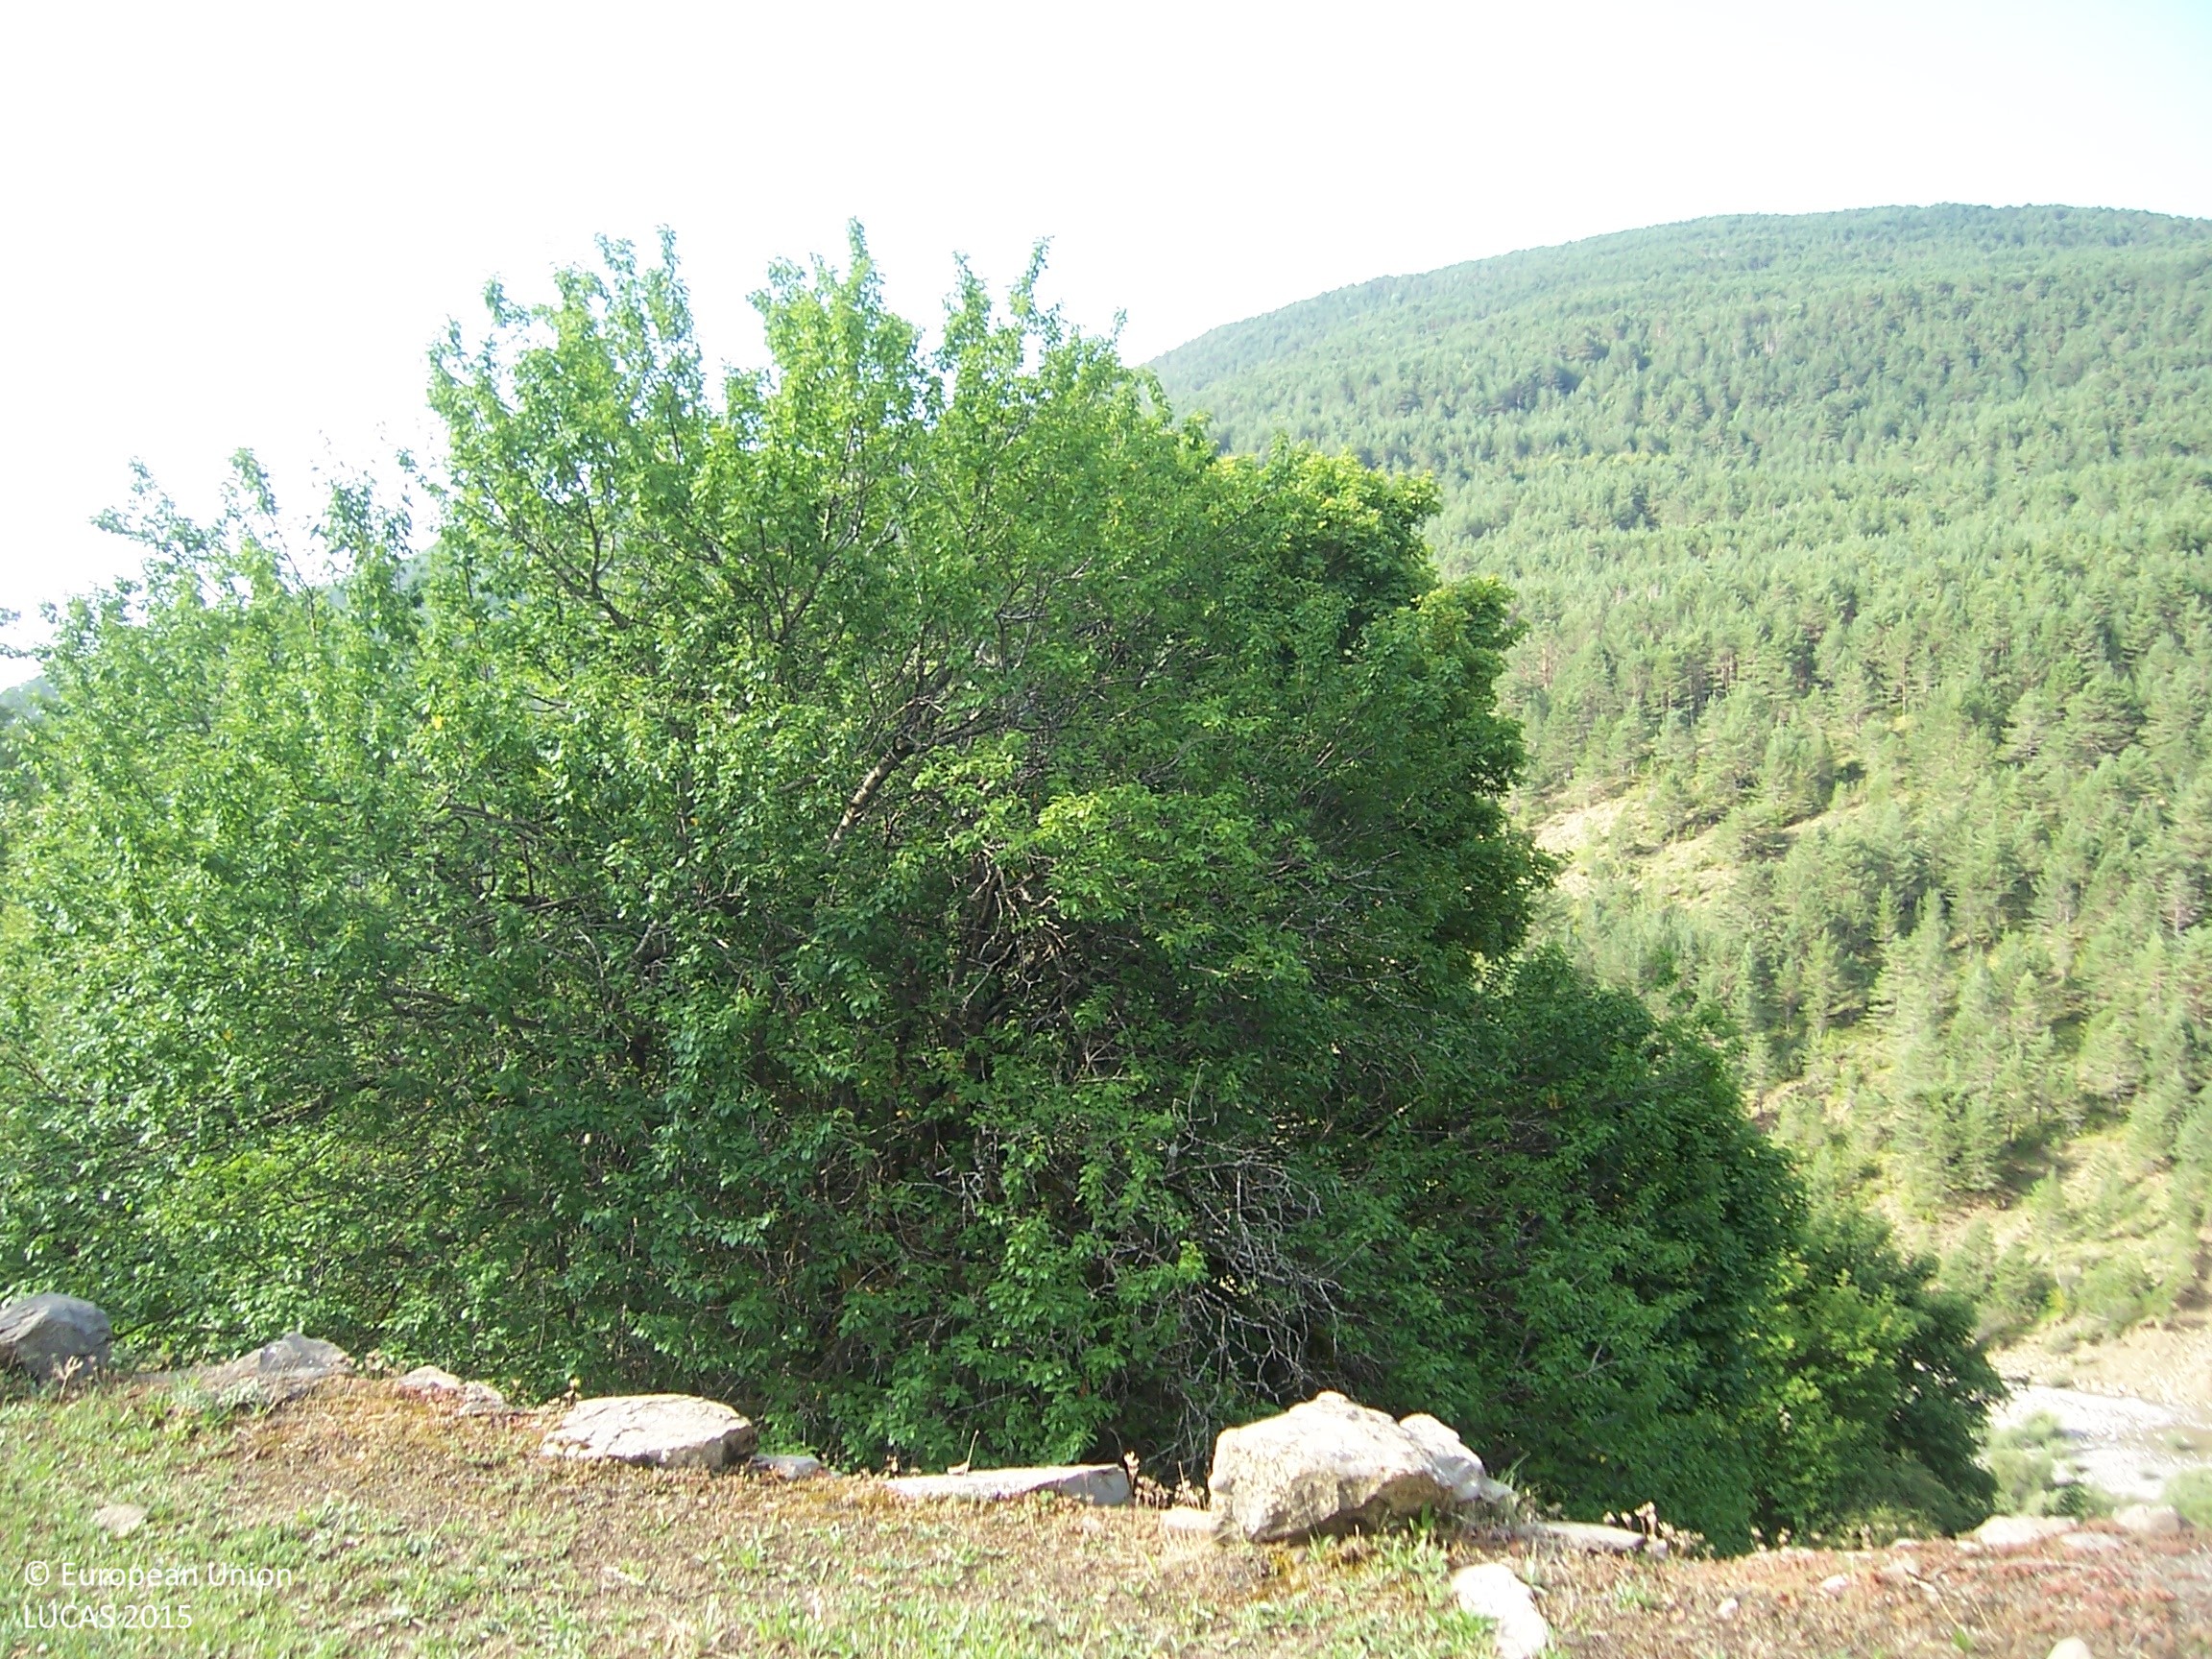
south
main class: Woodland
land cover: Broadleaved woodland
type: floodplain forest
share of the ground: > 75 %
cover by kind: broadleaved forest trees 50 %, herbaceous plants 20 %, consolidated bare surface 20 %, shrubs 10 %
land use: Semi-natural and natural areas not in use
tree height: > 5 m
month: August
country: ES
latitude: 42.6774
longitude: -0.4364
